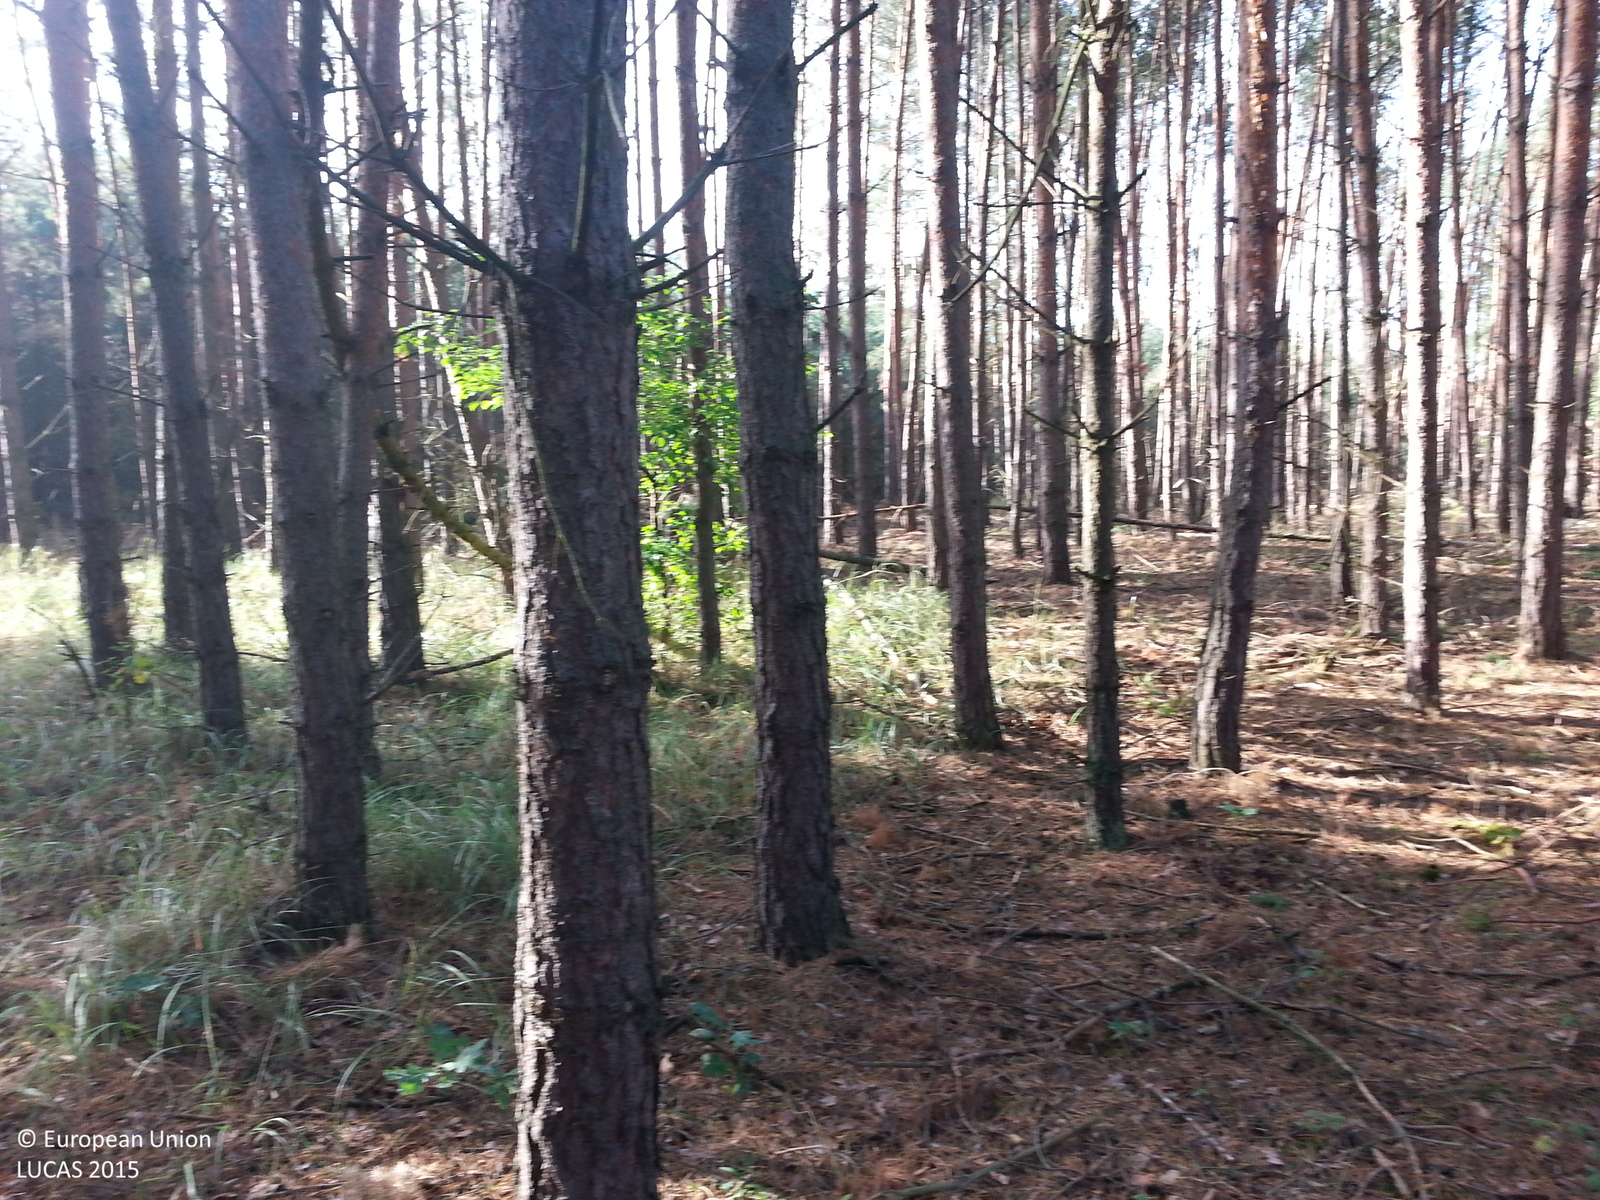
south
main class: Woodland
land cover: Pine dominated coniferous woodland
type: hemiboreal forest and nemoral coniferous forest and mixed broadleaved-coniferous forest
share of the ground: > 75 %
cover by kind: coniferous forest trees 70 %, broadleaved forest trees 10 %, herbaceous plants 10 %, lichens and mosses 5 %, unconsolidated bare surface 5 %
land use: Forestry
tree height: > 5 m
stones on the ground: < 10 %
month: September
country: PL
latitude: 53.1448
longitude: 19.1588
